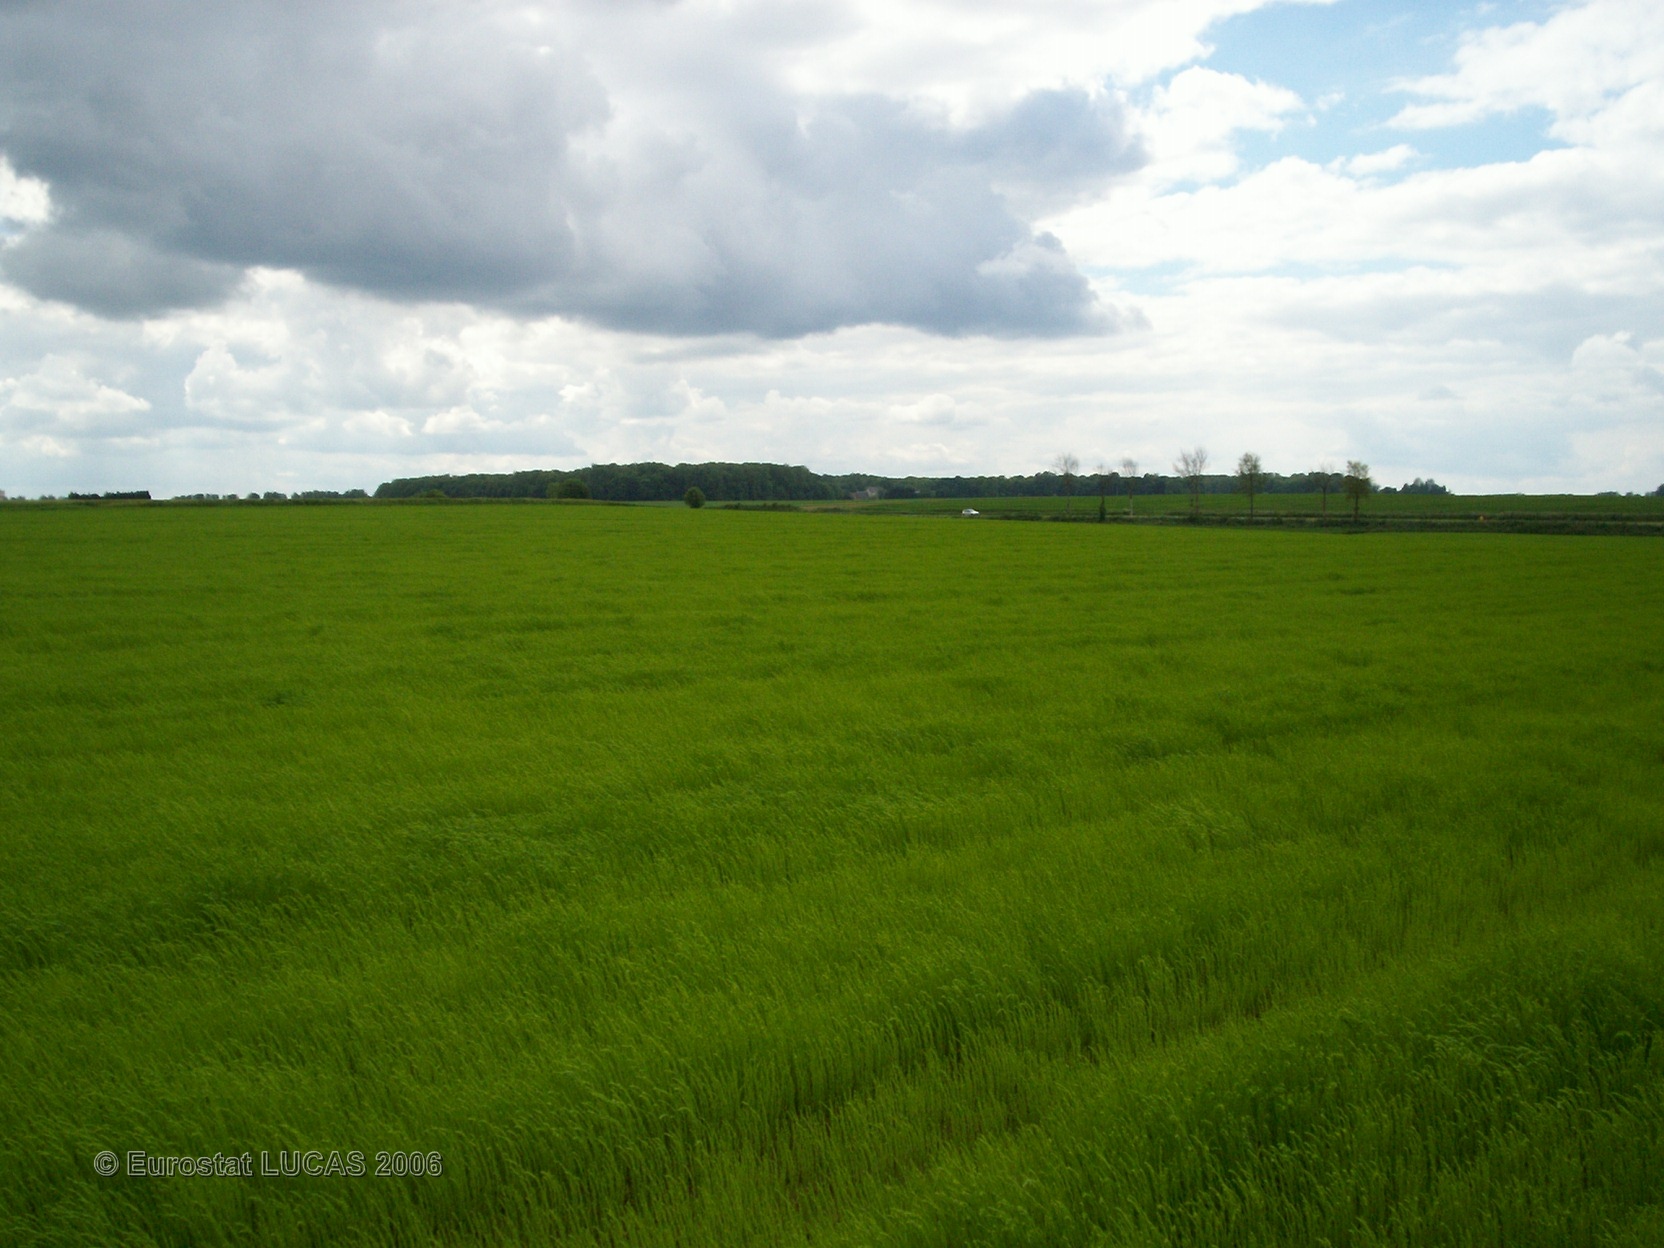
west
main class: Cropland
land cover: Other fibre and oleaginous crops
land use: Agriculture (excluding fallow land and kitchen gardens)
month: May
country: FR
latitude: 50.1950
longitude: 2.5777
